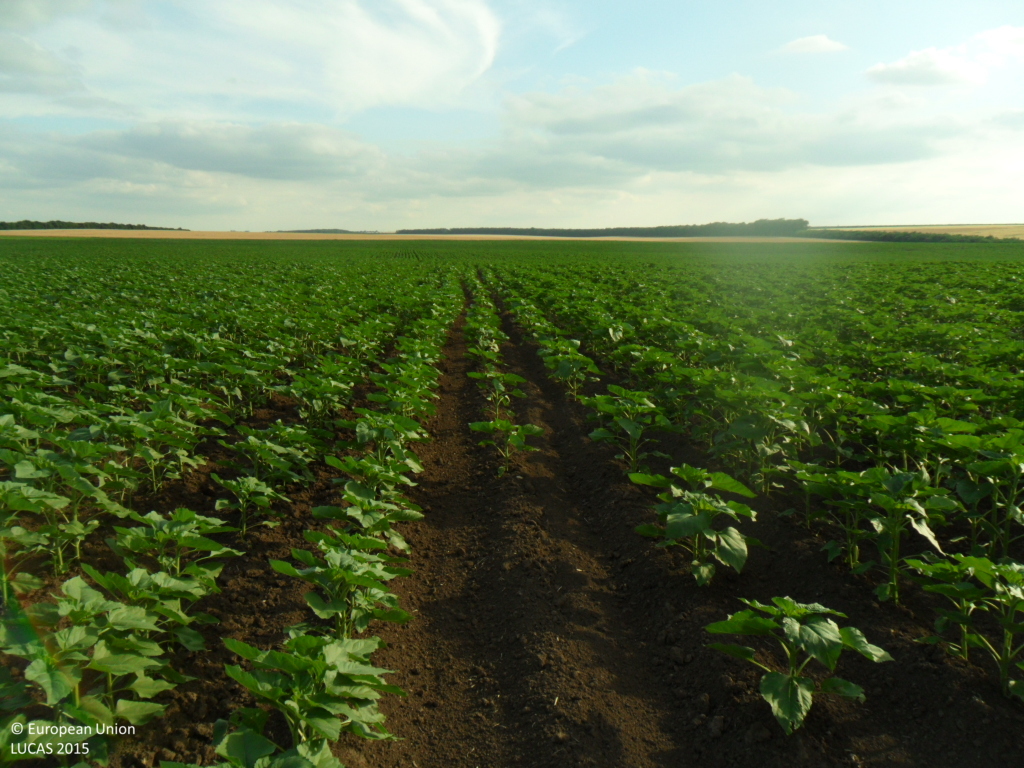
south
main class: Cropland
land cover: Sunflower
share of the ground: > 75 %
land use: Agriculture (excluding fallow land and kitchen gardens)
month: June
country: BG
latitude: 43.7699
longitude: 26.8504
